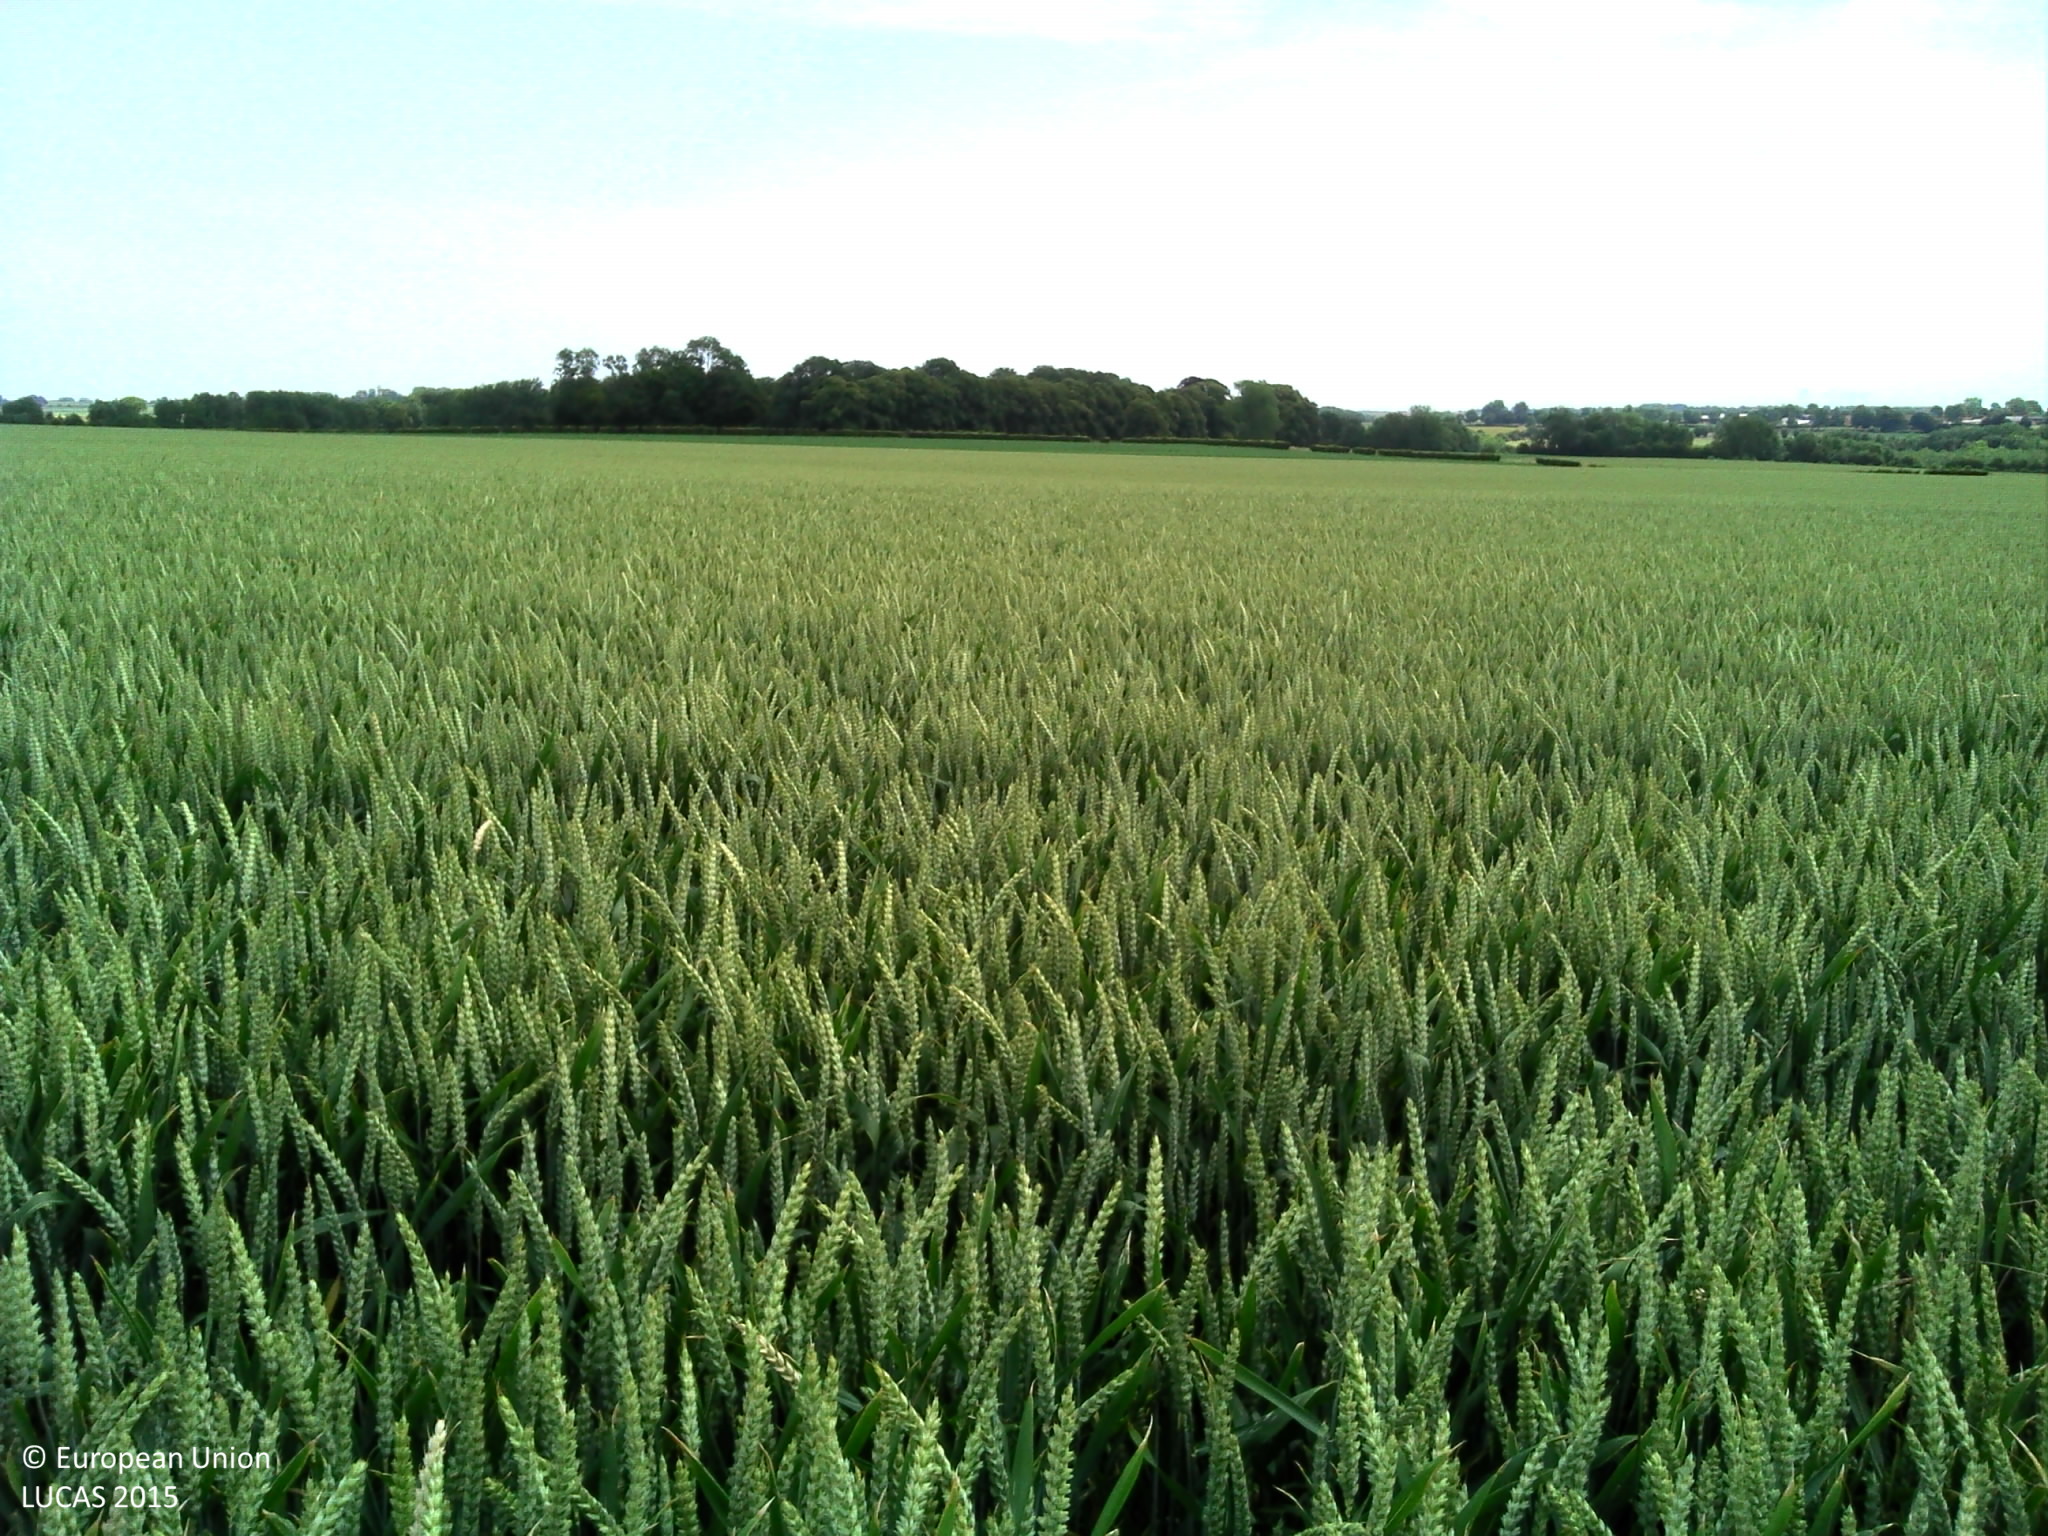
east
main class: Cropland
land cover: Common wheat
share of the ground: > 75 %
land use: Agriculture (excluding fallow land and kitchen gardens)
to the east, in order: Common wheat; Maize
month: July
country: FR
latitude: 50.3832
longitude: 2.1519
